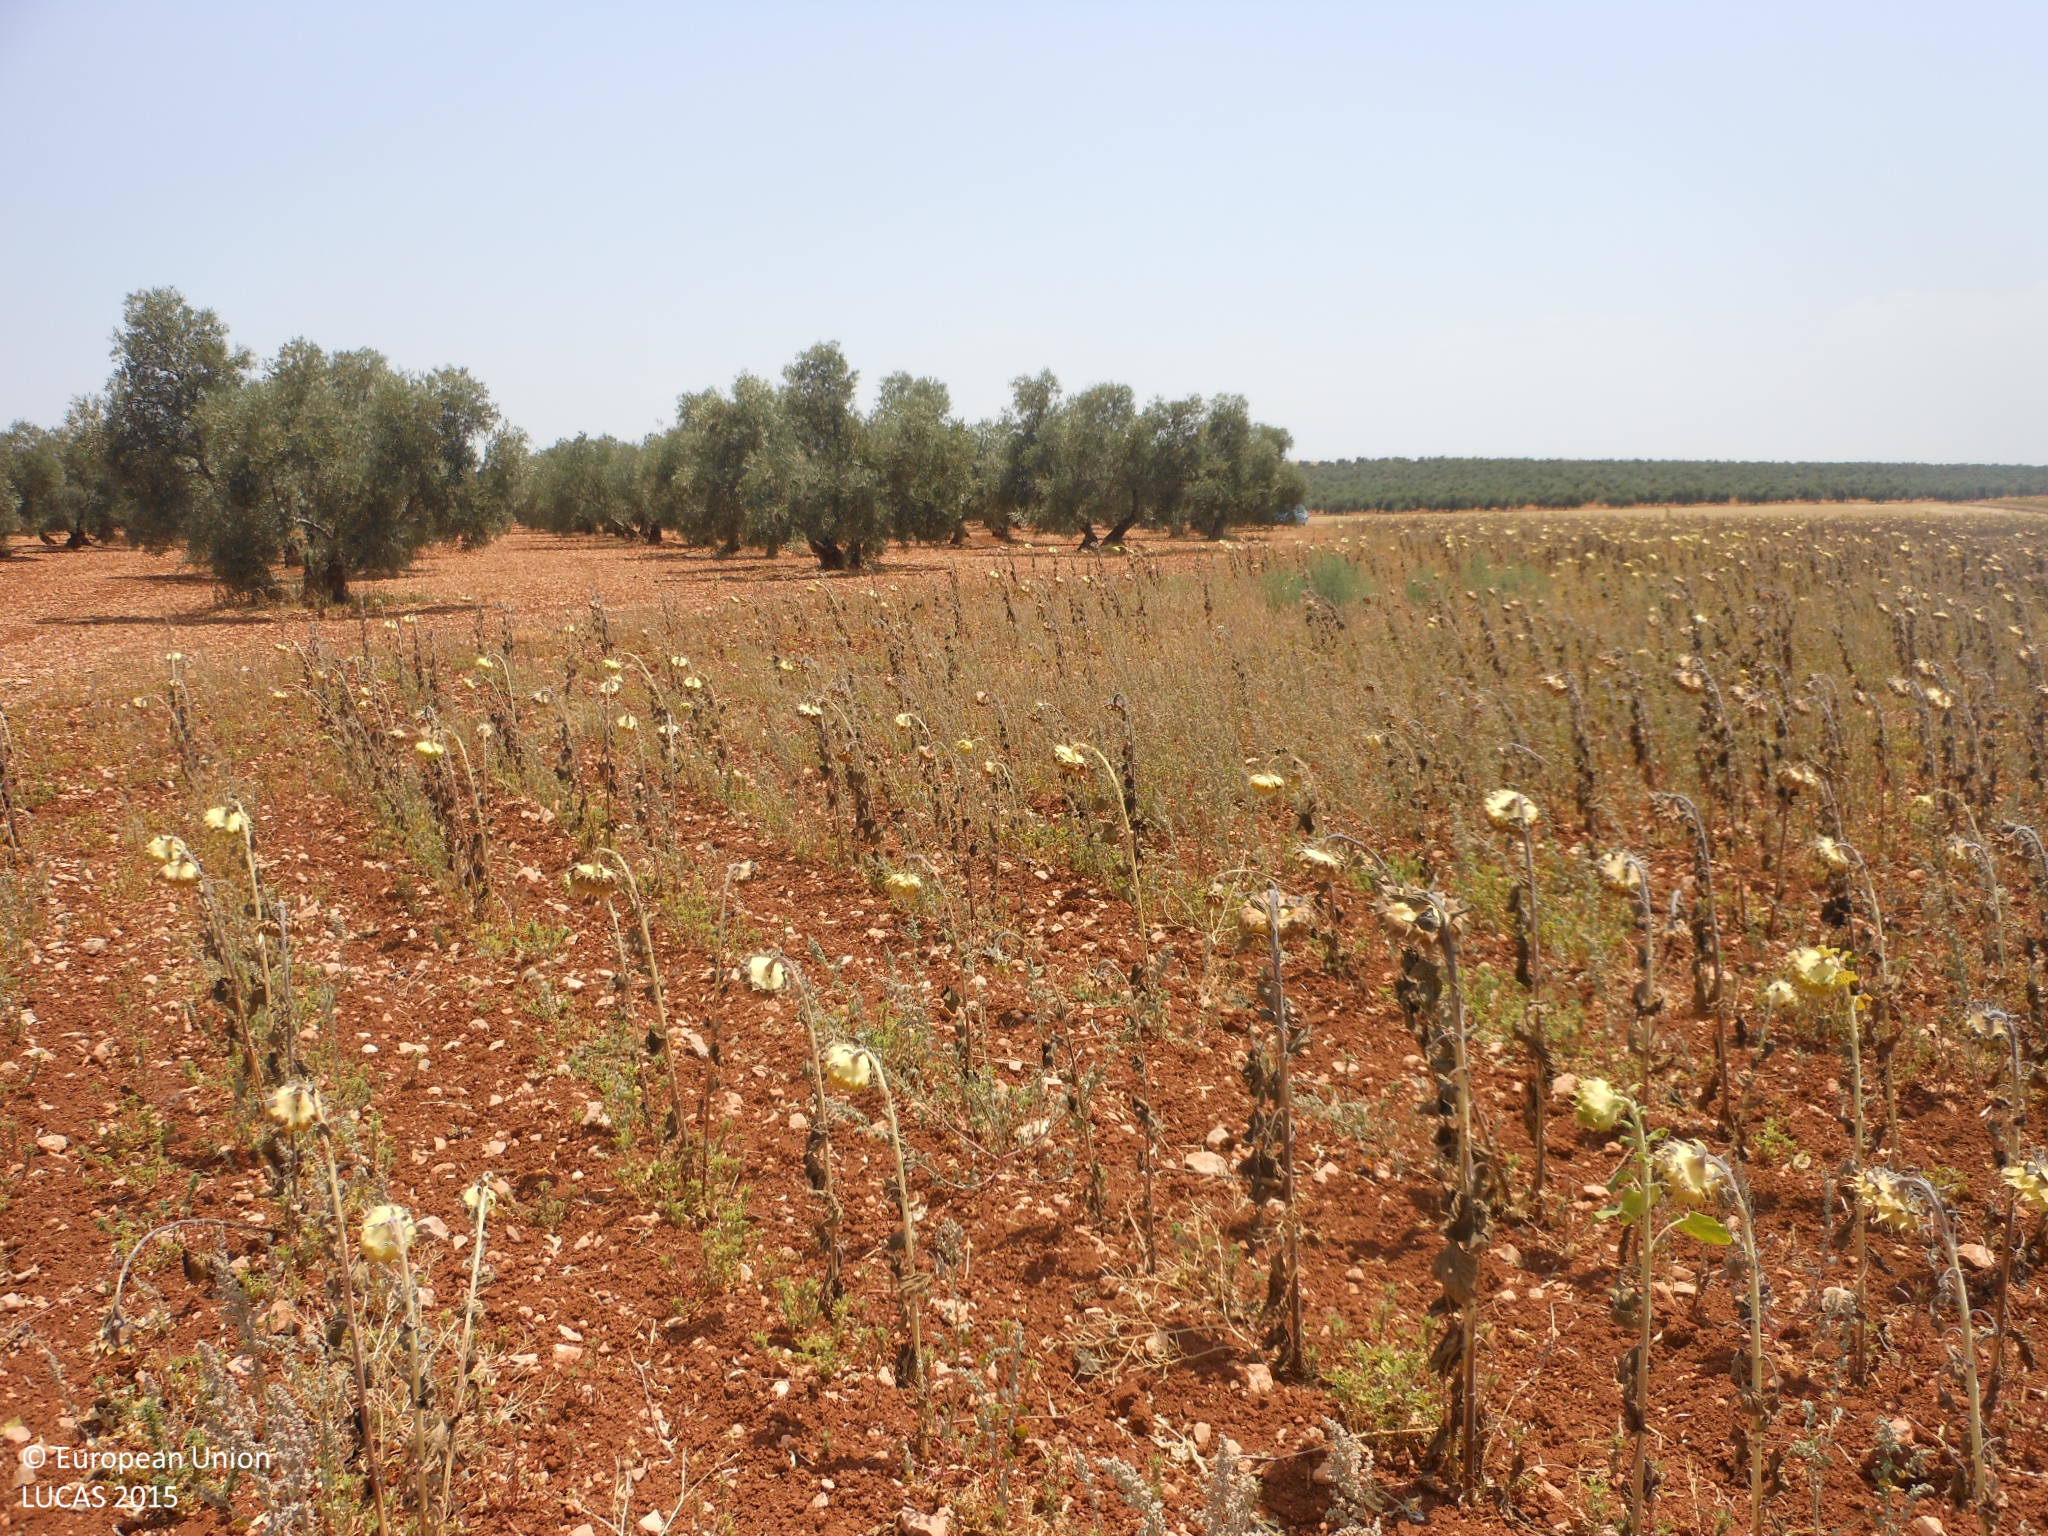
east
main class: Cropland
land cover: Sunflower
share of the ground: 25 - 50 %
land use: Agriculture (excluding fallow land and kitchen gardens)
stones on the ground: 10 - 25 %
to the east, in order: Sunflower; Olive groves
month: July
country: ES
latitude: 37.3617
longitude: -5.1055
